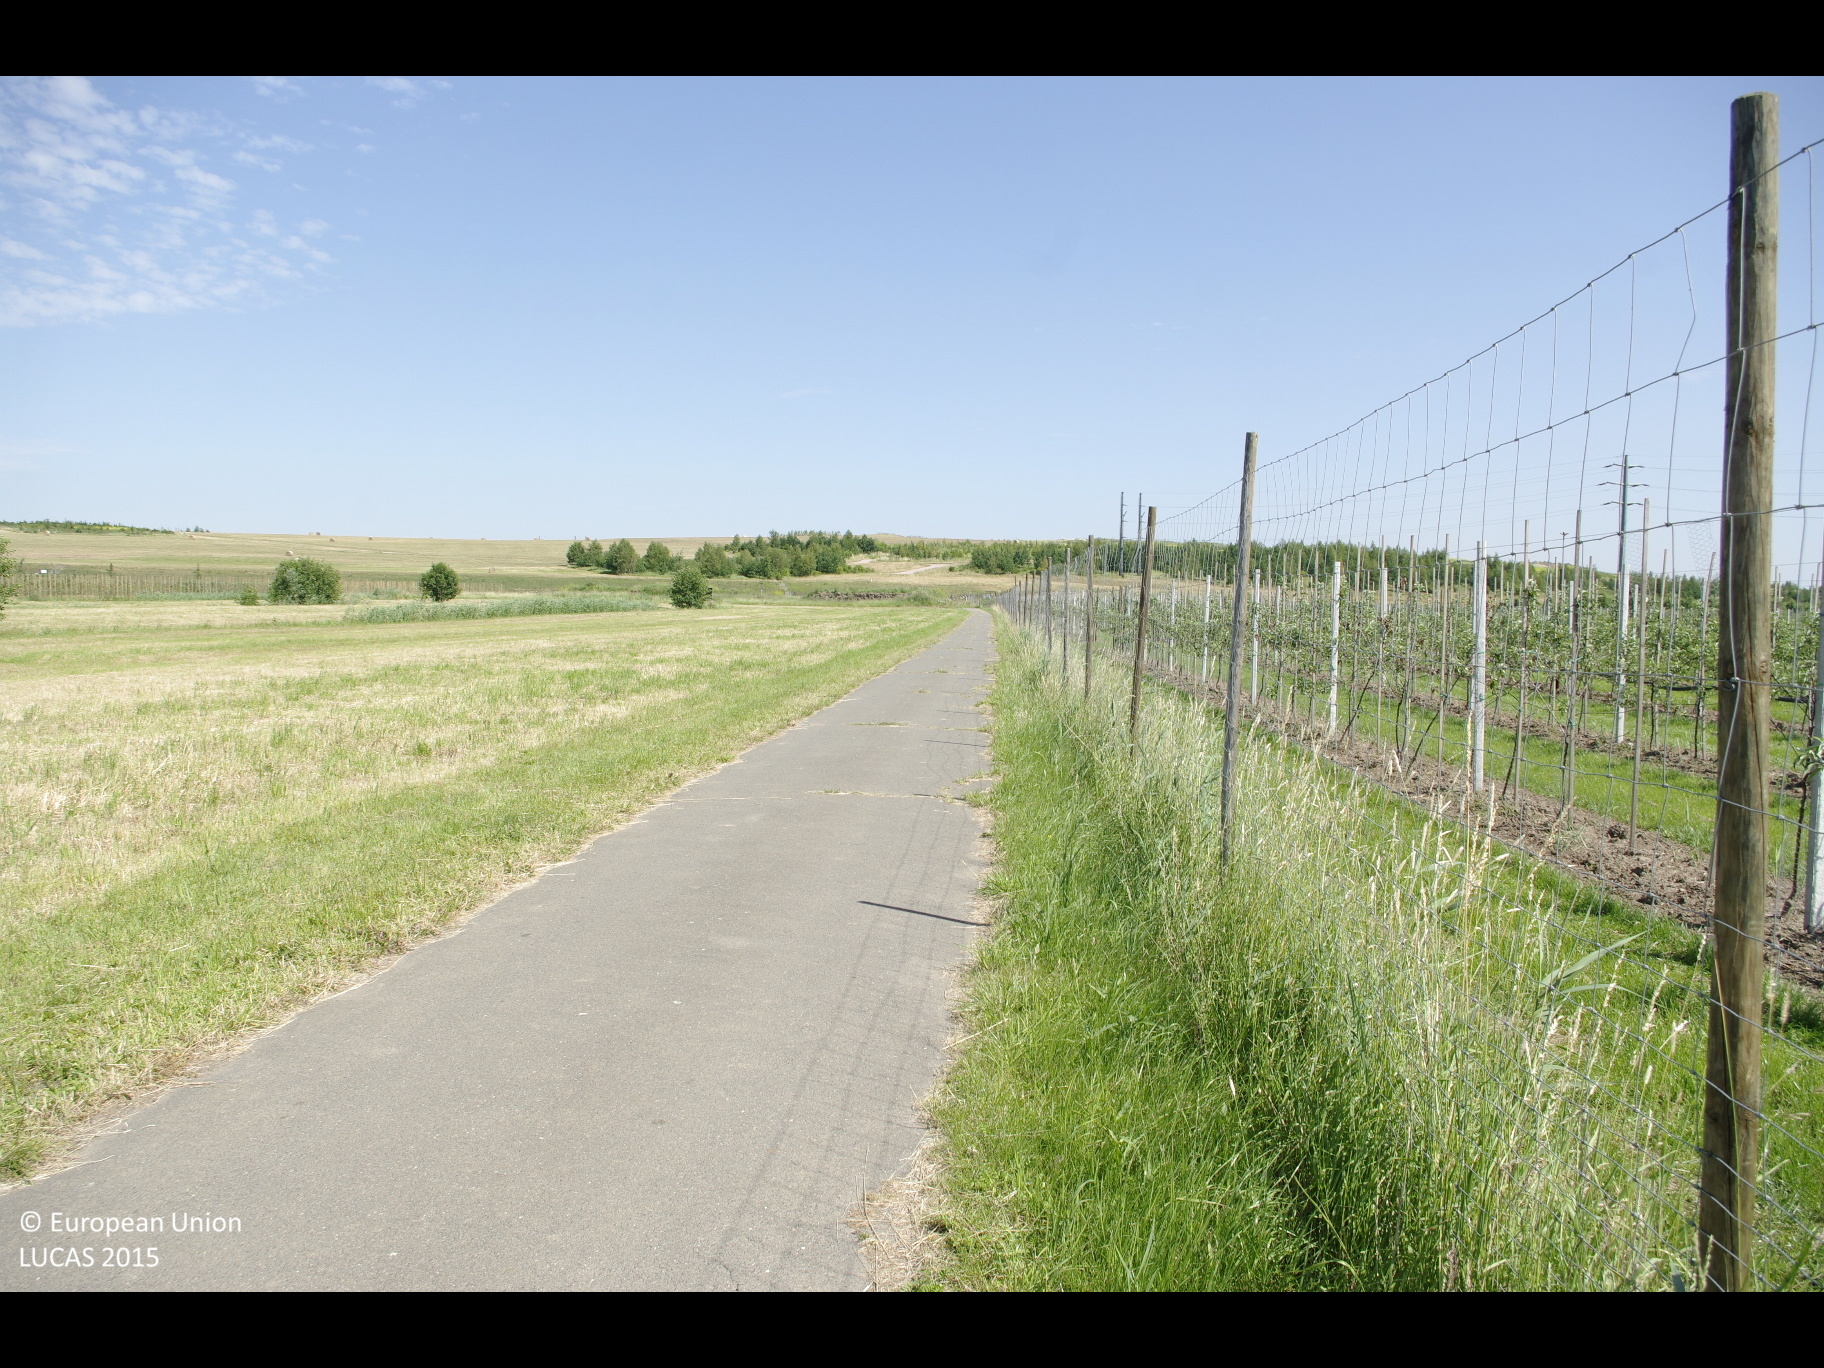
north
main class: Grassland
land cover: Grassland without tree/shrub cover
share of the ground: > 75 %
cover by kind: herbaceous plants 100 %
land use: Agriculture (excluding fallow land and kitchen gardens)
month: July
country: DE
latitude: 53.5097
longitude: 9.8644
